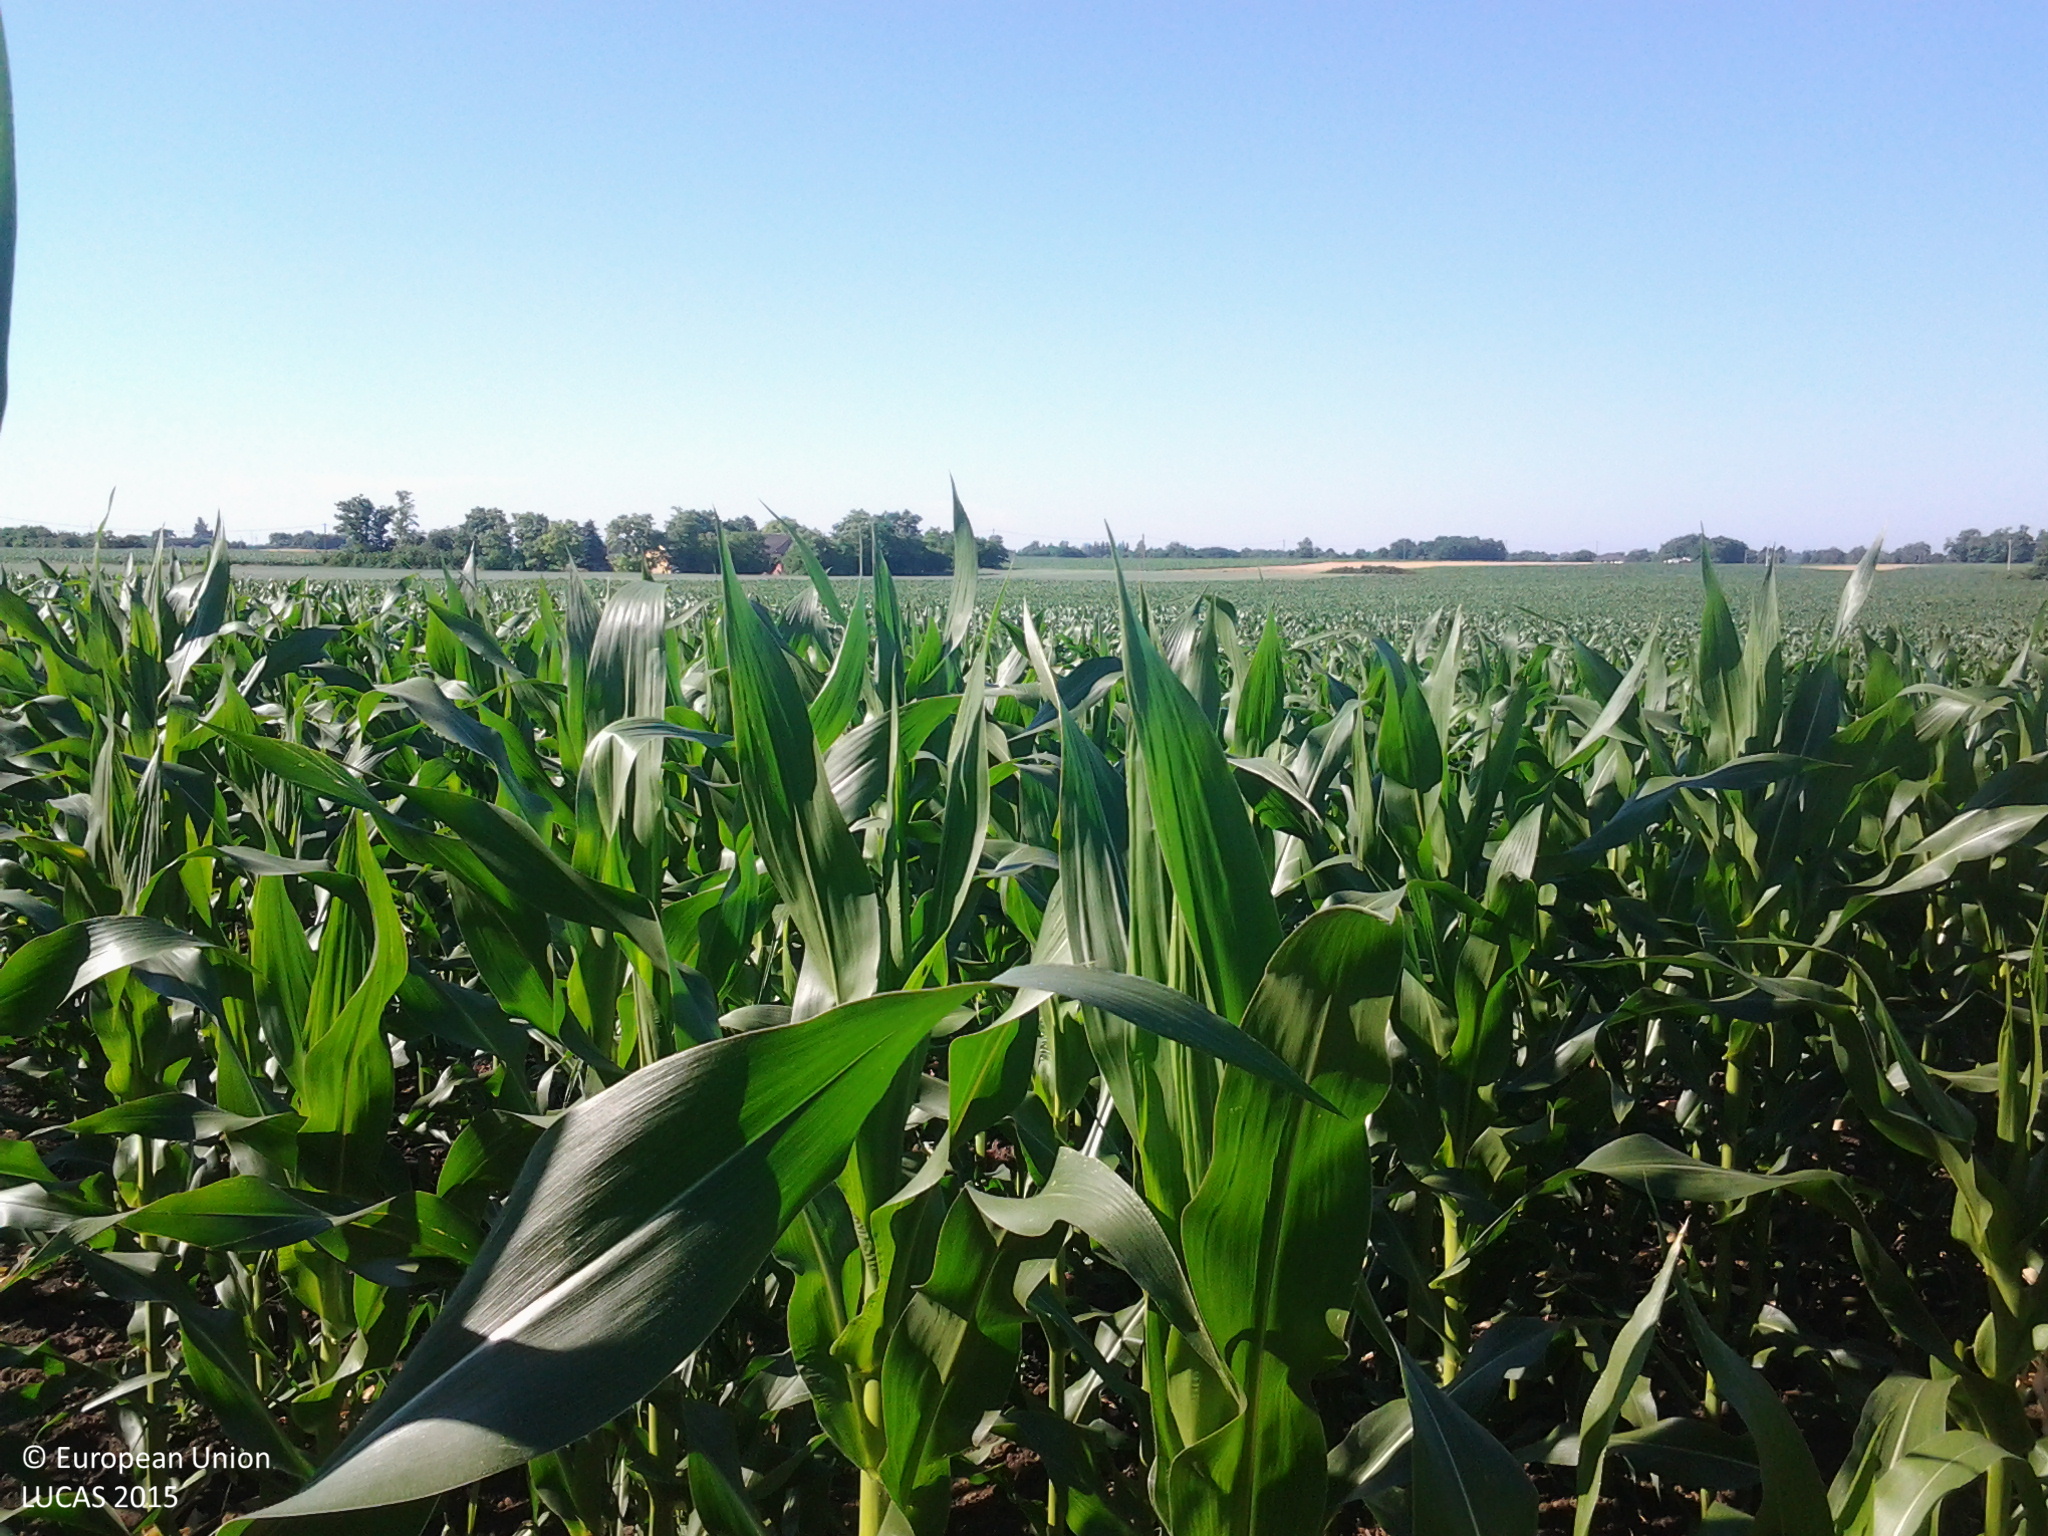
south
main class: Cropland
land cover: Maize
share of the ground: > 75 %
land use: Agriculture (excluding fallow land and kitchen gardens)
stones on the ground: < 10 %
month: June
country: HU
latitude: 46.9652
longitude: 19.6542
